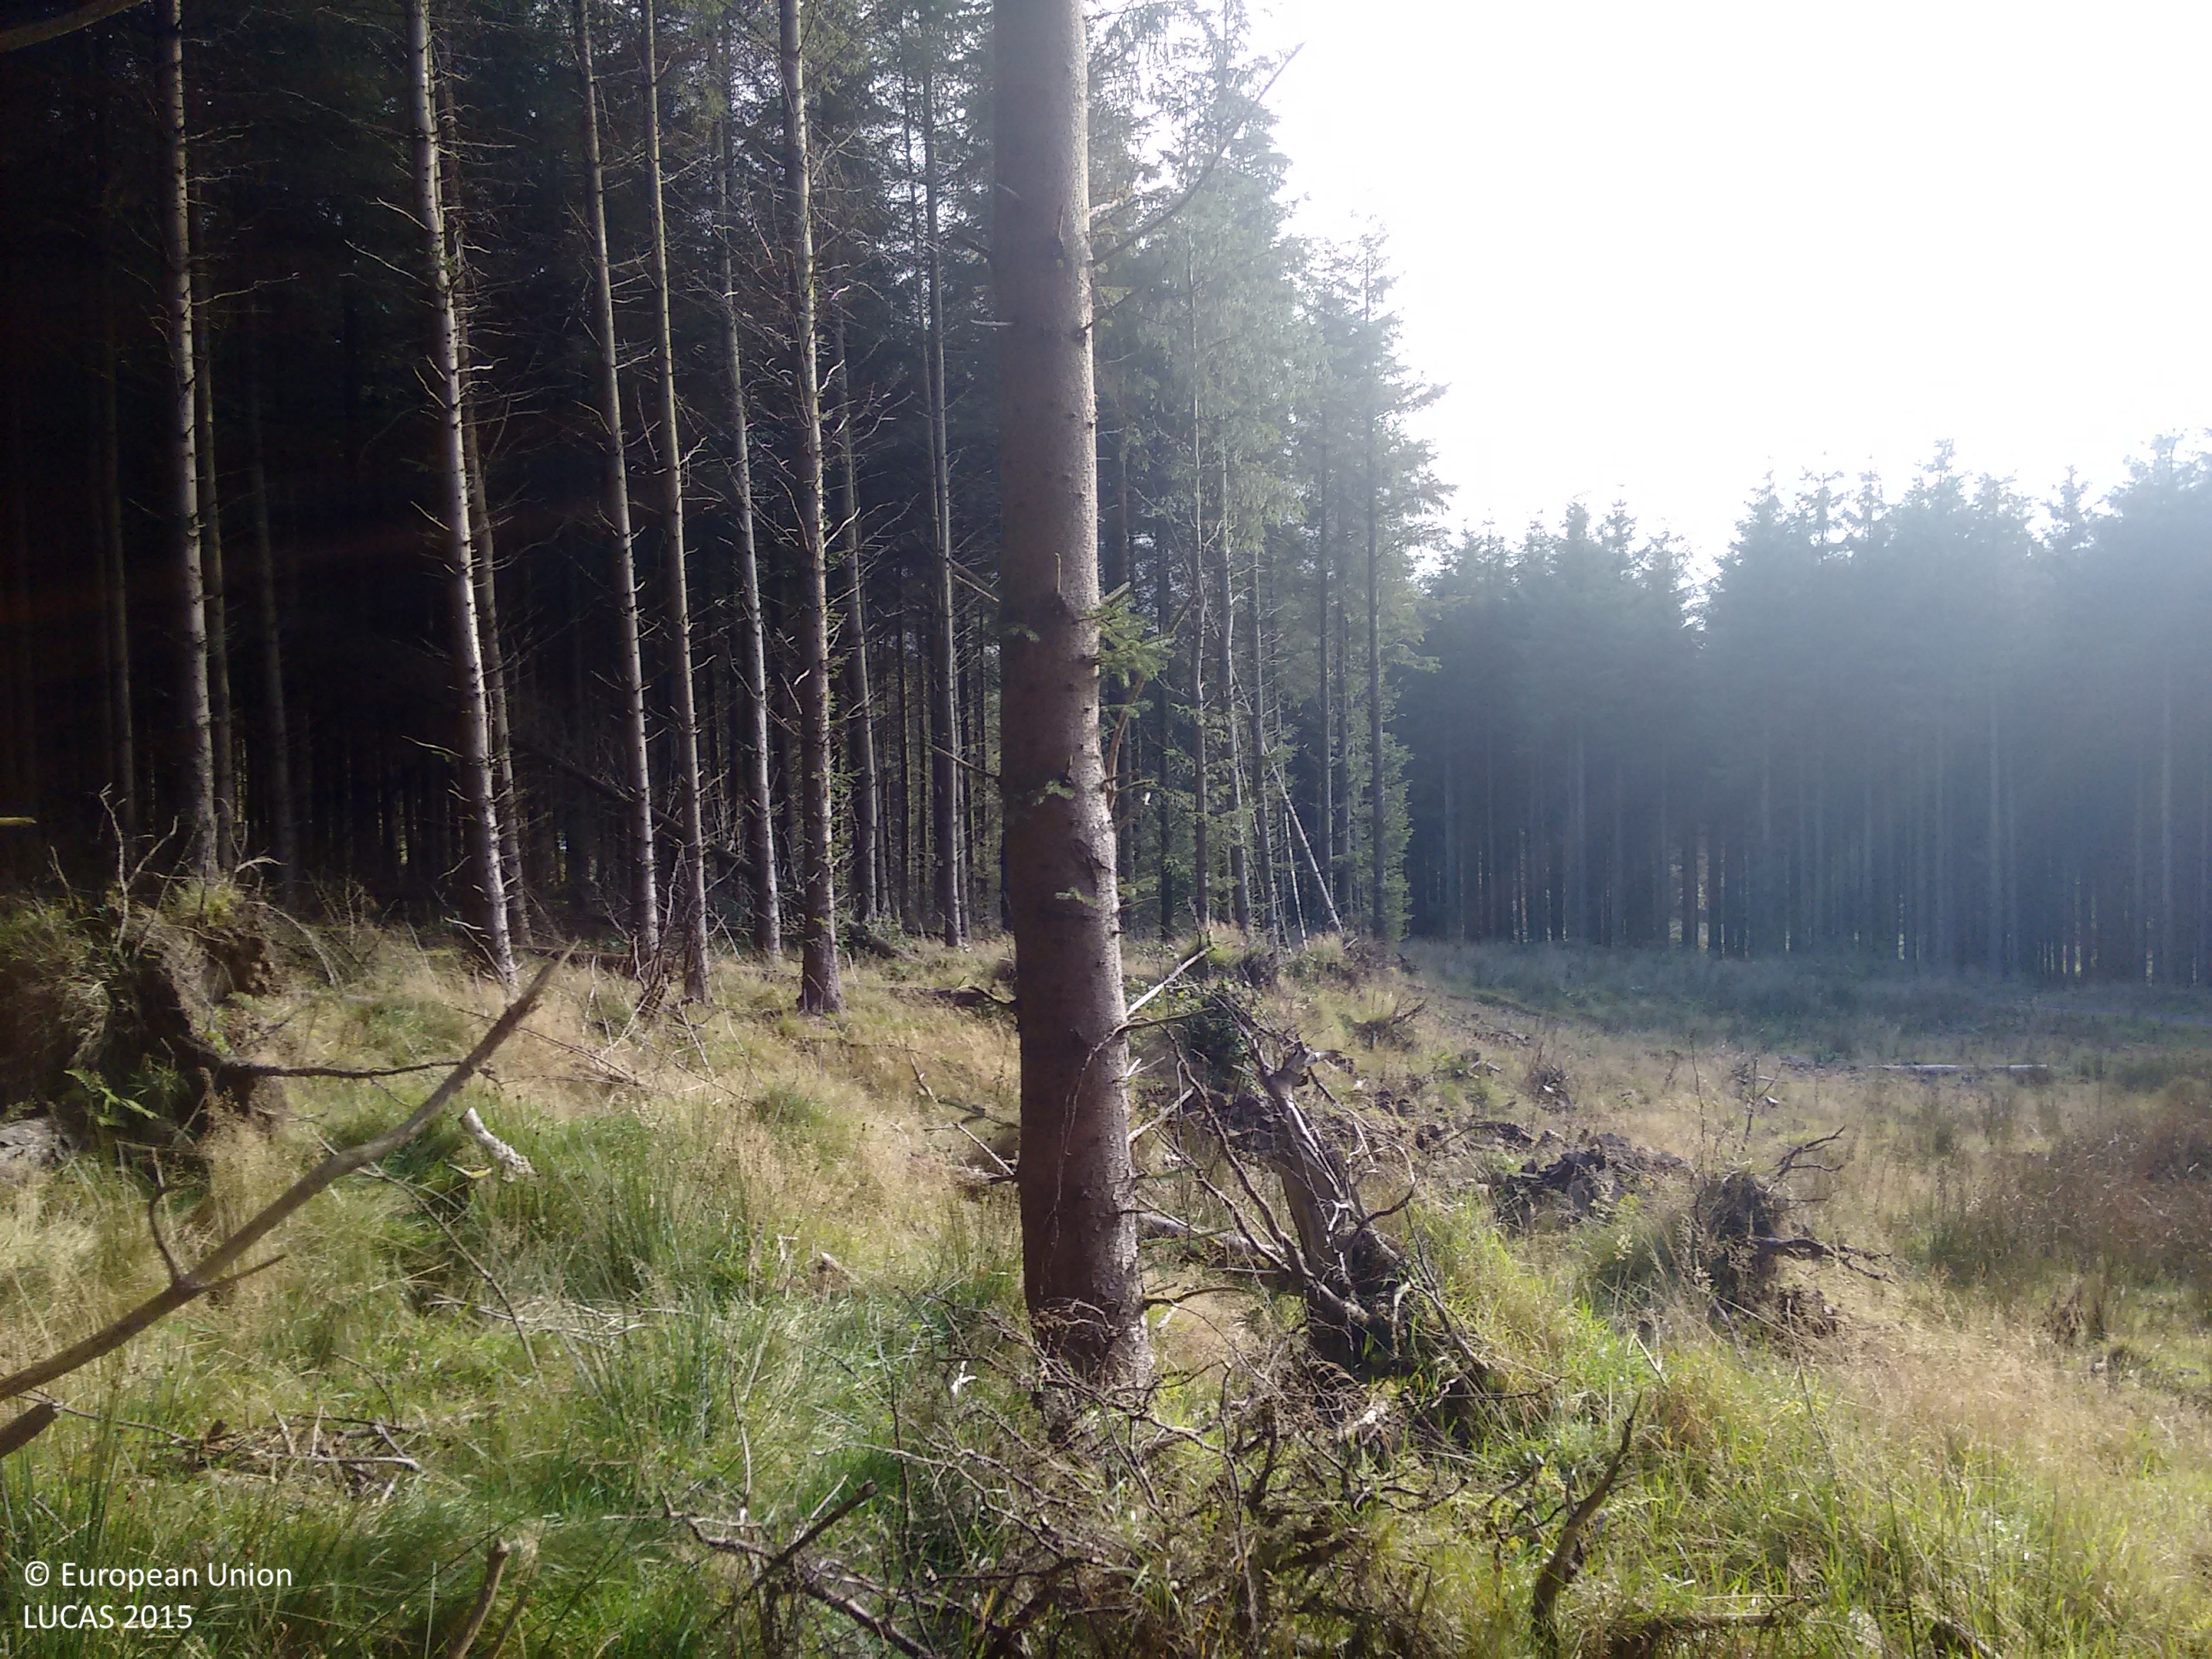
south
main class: Woodland
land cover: Spruce dominated coniferous woodland
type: exotic forest
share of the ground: > 75 %
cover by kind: coniferous forest trees 65 %, herbaceous plants 35 %
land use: Forestry
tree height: > 5 m
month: October
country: IE
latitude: 52.9905
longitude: -7.6686
